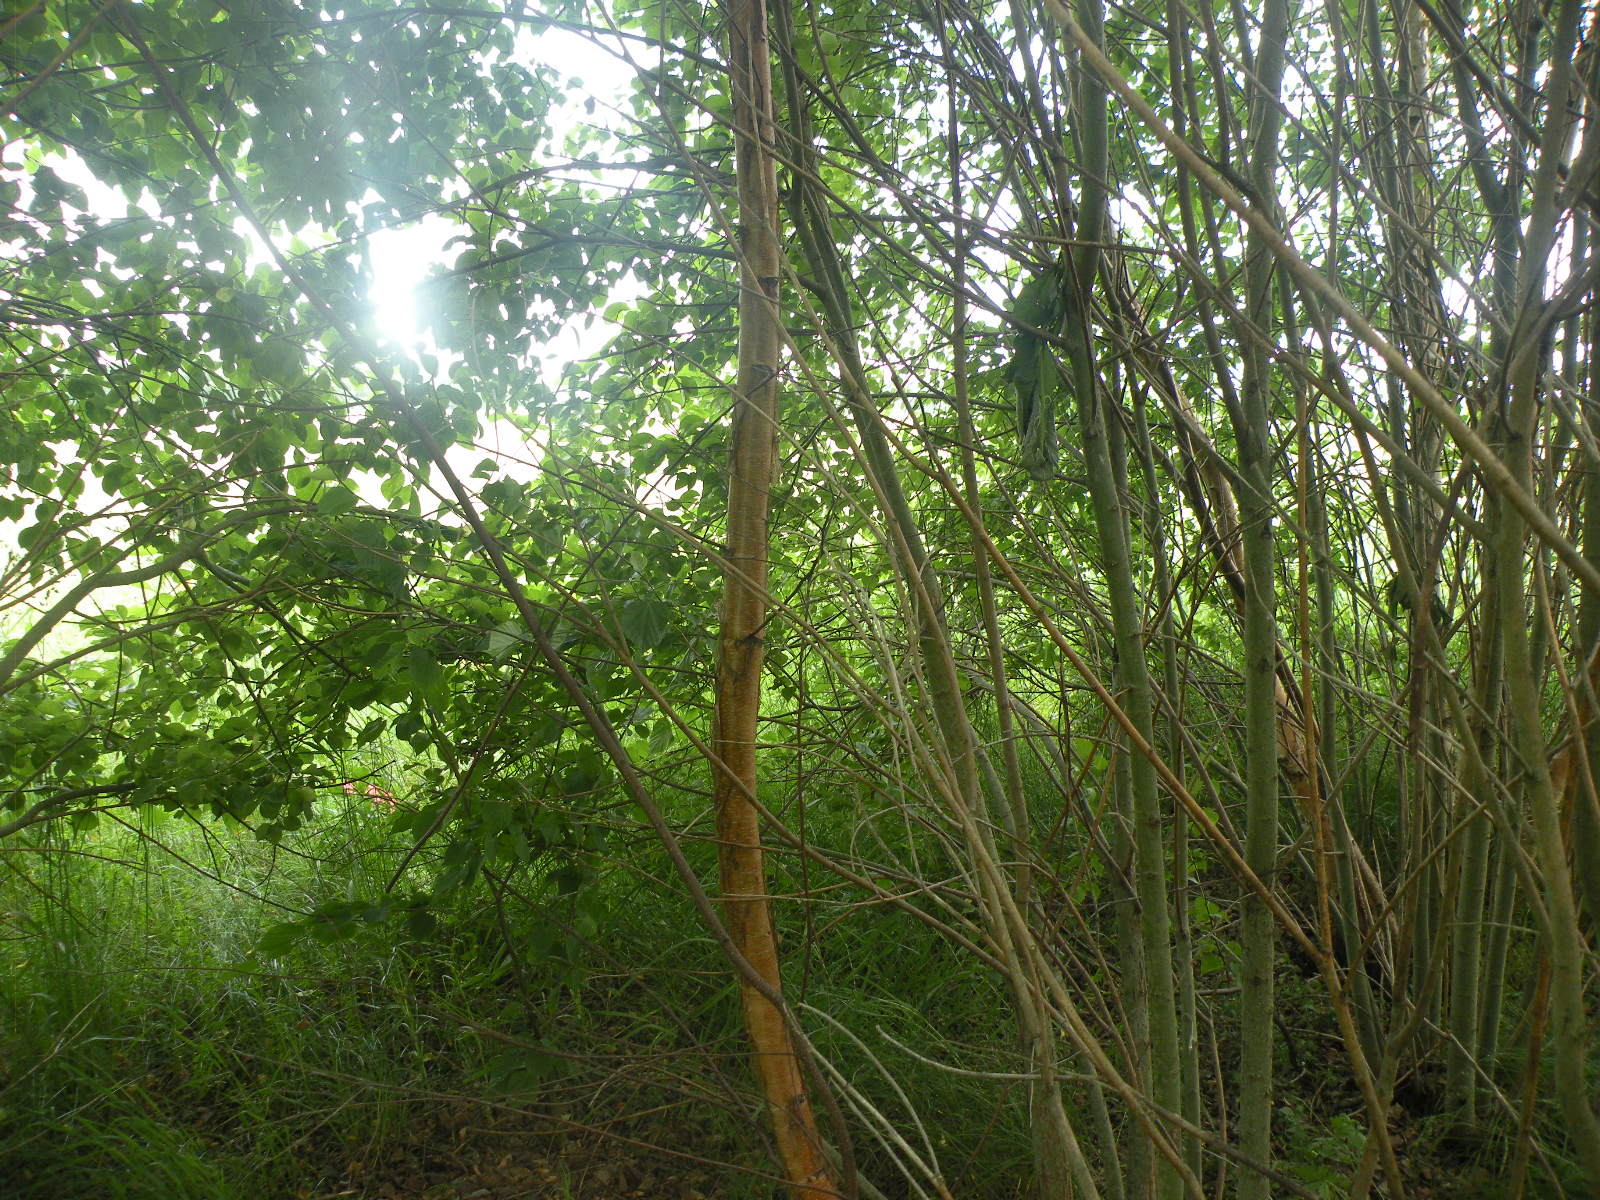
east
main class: Woodland
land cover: Broadleaved woodland
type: non-riverine alder, birch or aspen forest
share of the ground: > 75 %
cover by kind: broadleaved forest trees 95 %, herbaceous plants 5 %
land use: Forestry
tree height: < 5 m
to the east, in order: Broadleaved woodland; Common wheat
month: June
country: LV
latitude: 55.9687
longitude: 26.6739
